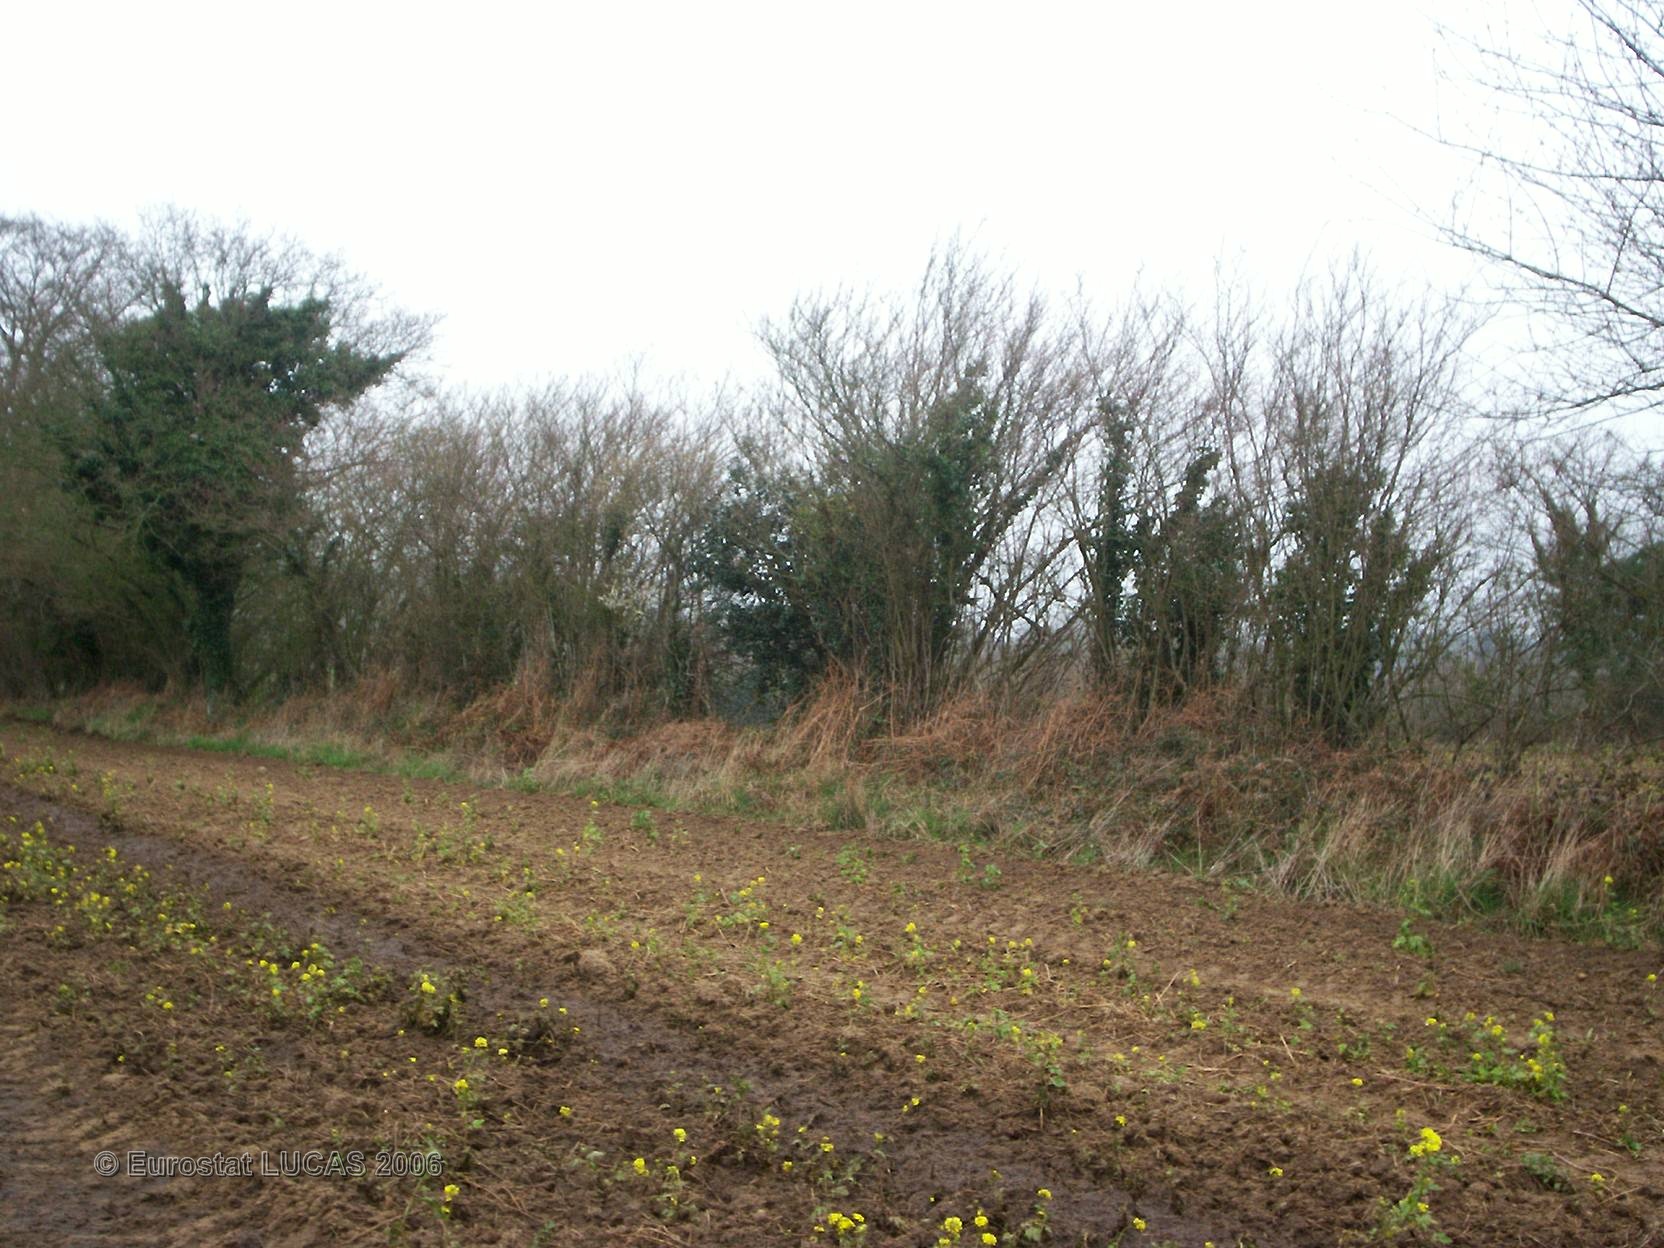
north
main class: Cropland
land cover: Maize
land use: Agriculture (excluding fallow land and kitchen gardens)
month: May
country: FR
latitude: 49.5159
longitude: -1.6120
